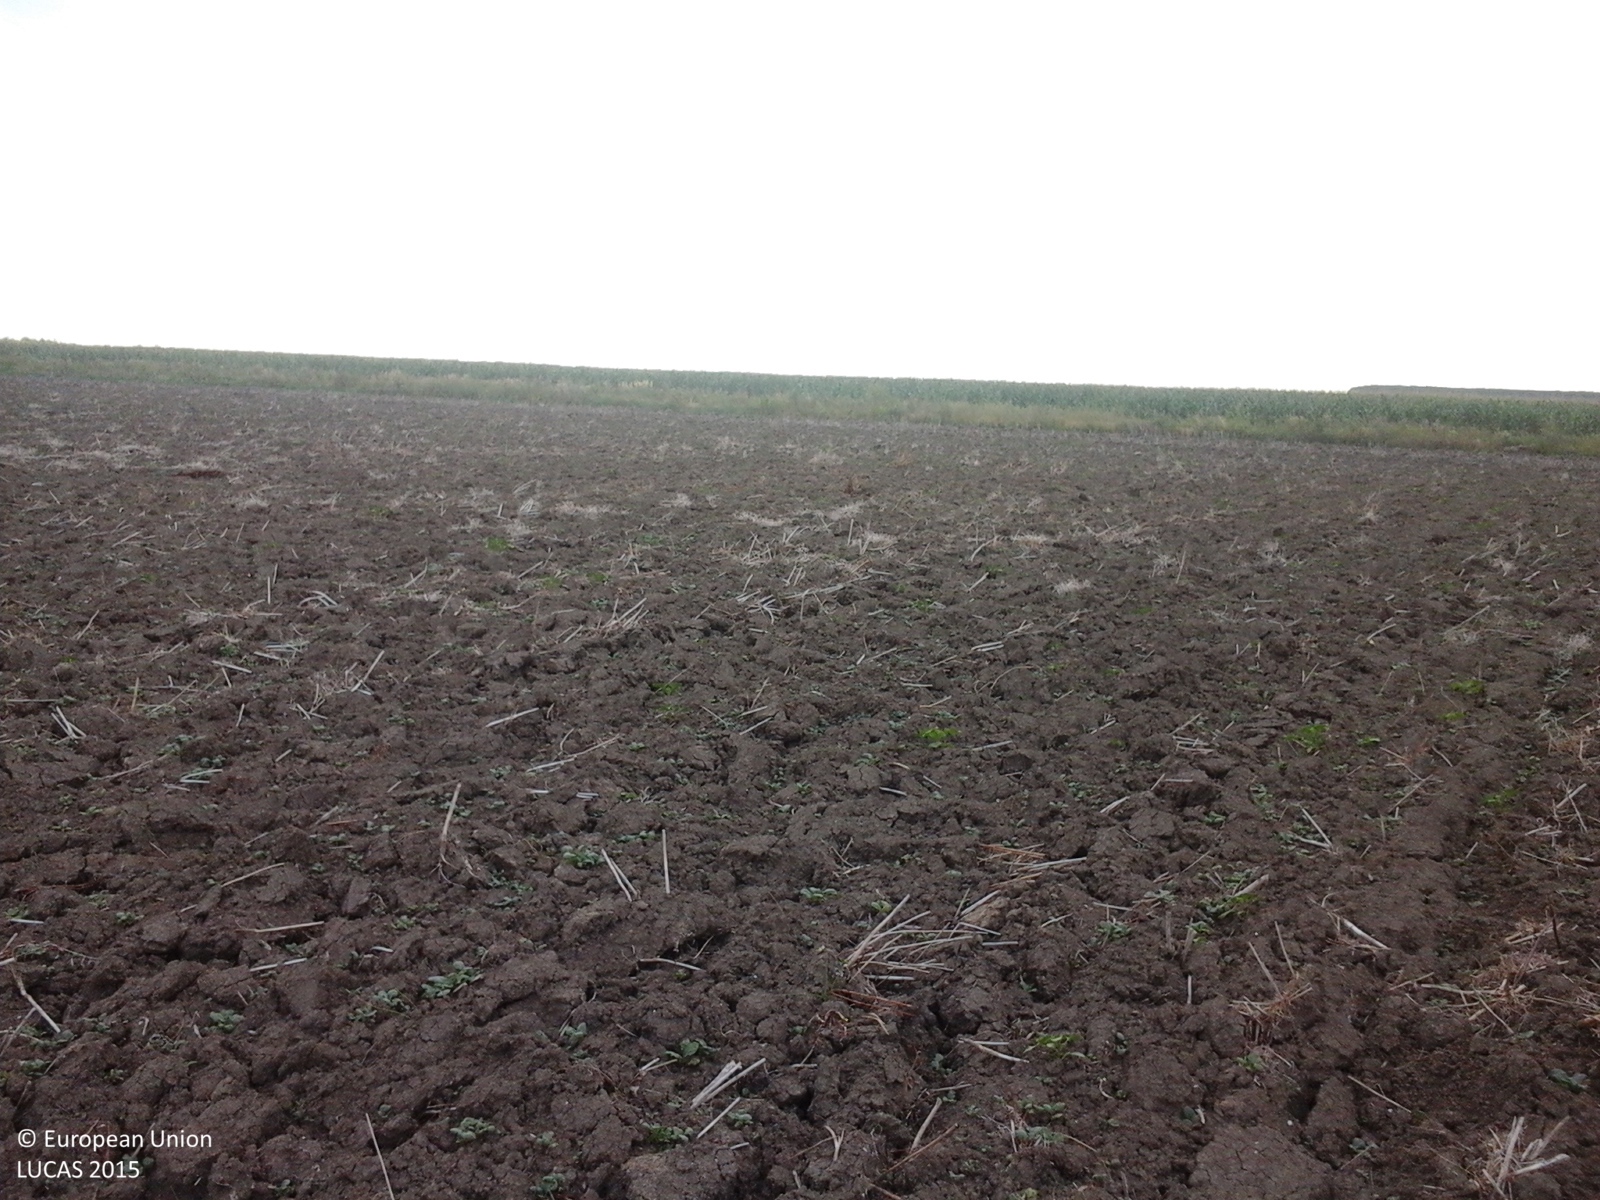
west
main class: Cropland
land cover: Rape and turnip rape
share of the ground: < 10 %
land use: Agriculture (excluding fallow land and kitchen gardens)
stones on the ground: < 10 %
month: August
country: RO
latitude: 44.7422
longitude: 28.0583
